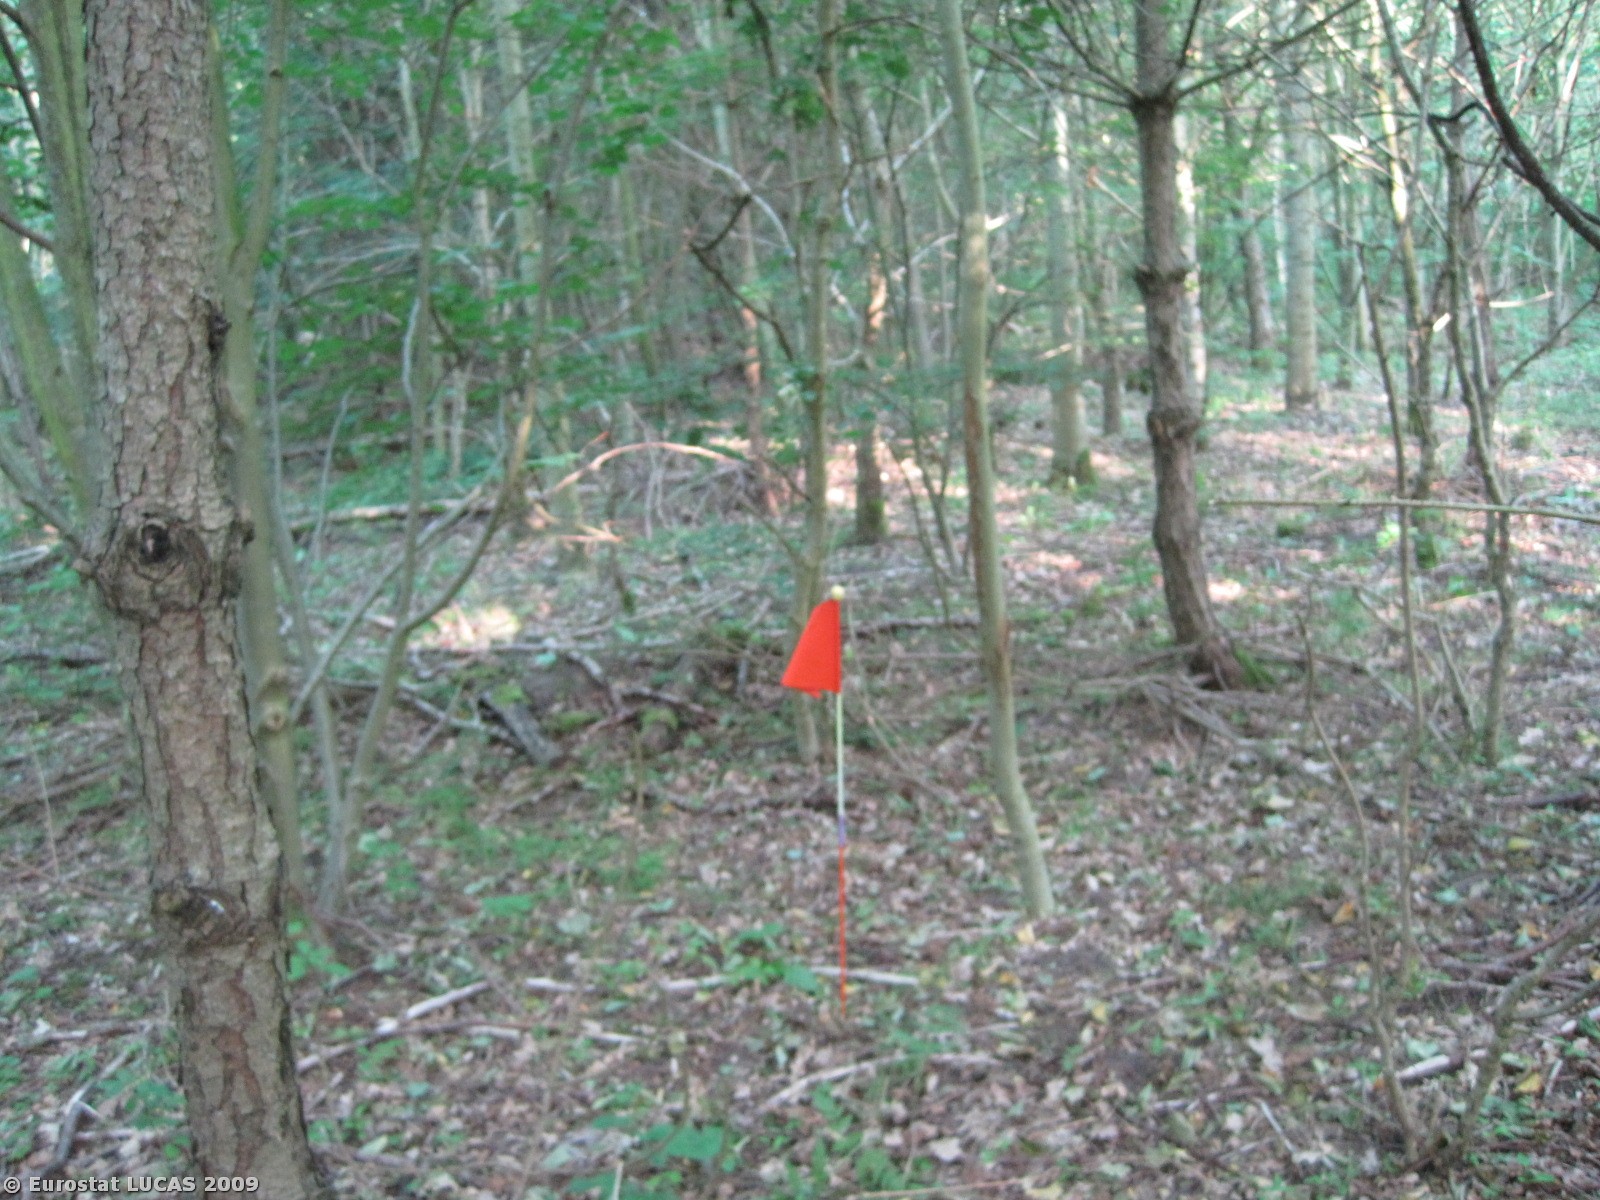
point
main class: Woodland
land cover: Broadleaved woodland
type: plantations and self-sown exotic forest
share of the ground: > 75 %
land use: Unused
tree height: > 5 m
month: July
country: DK
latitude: 56.3747
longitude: 8.3342
